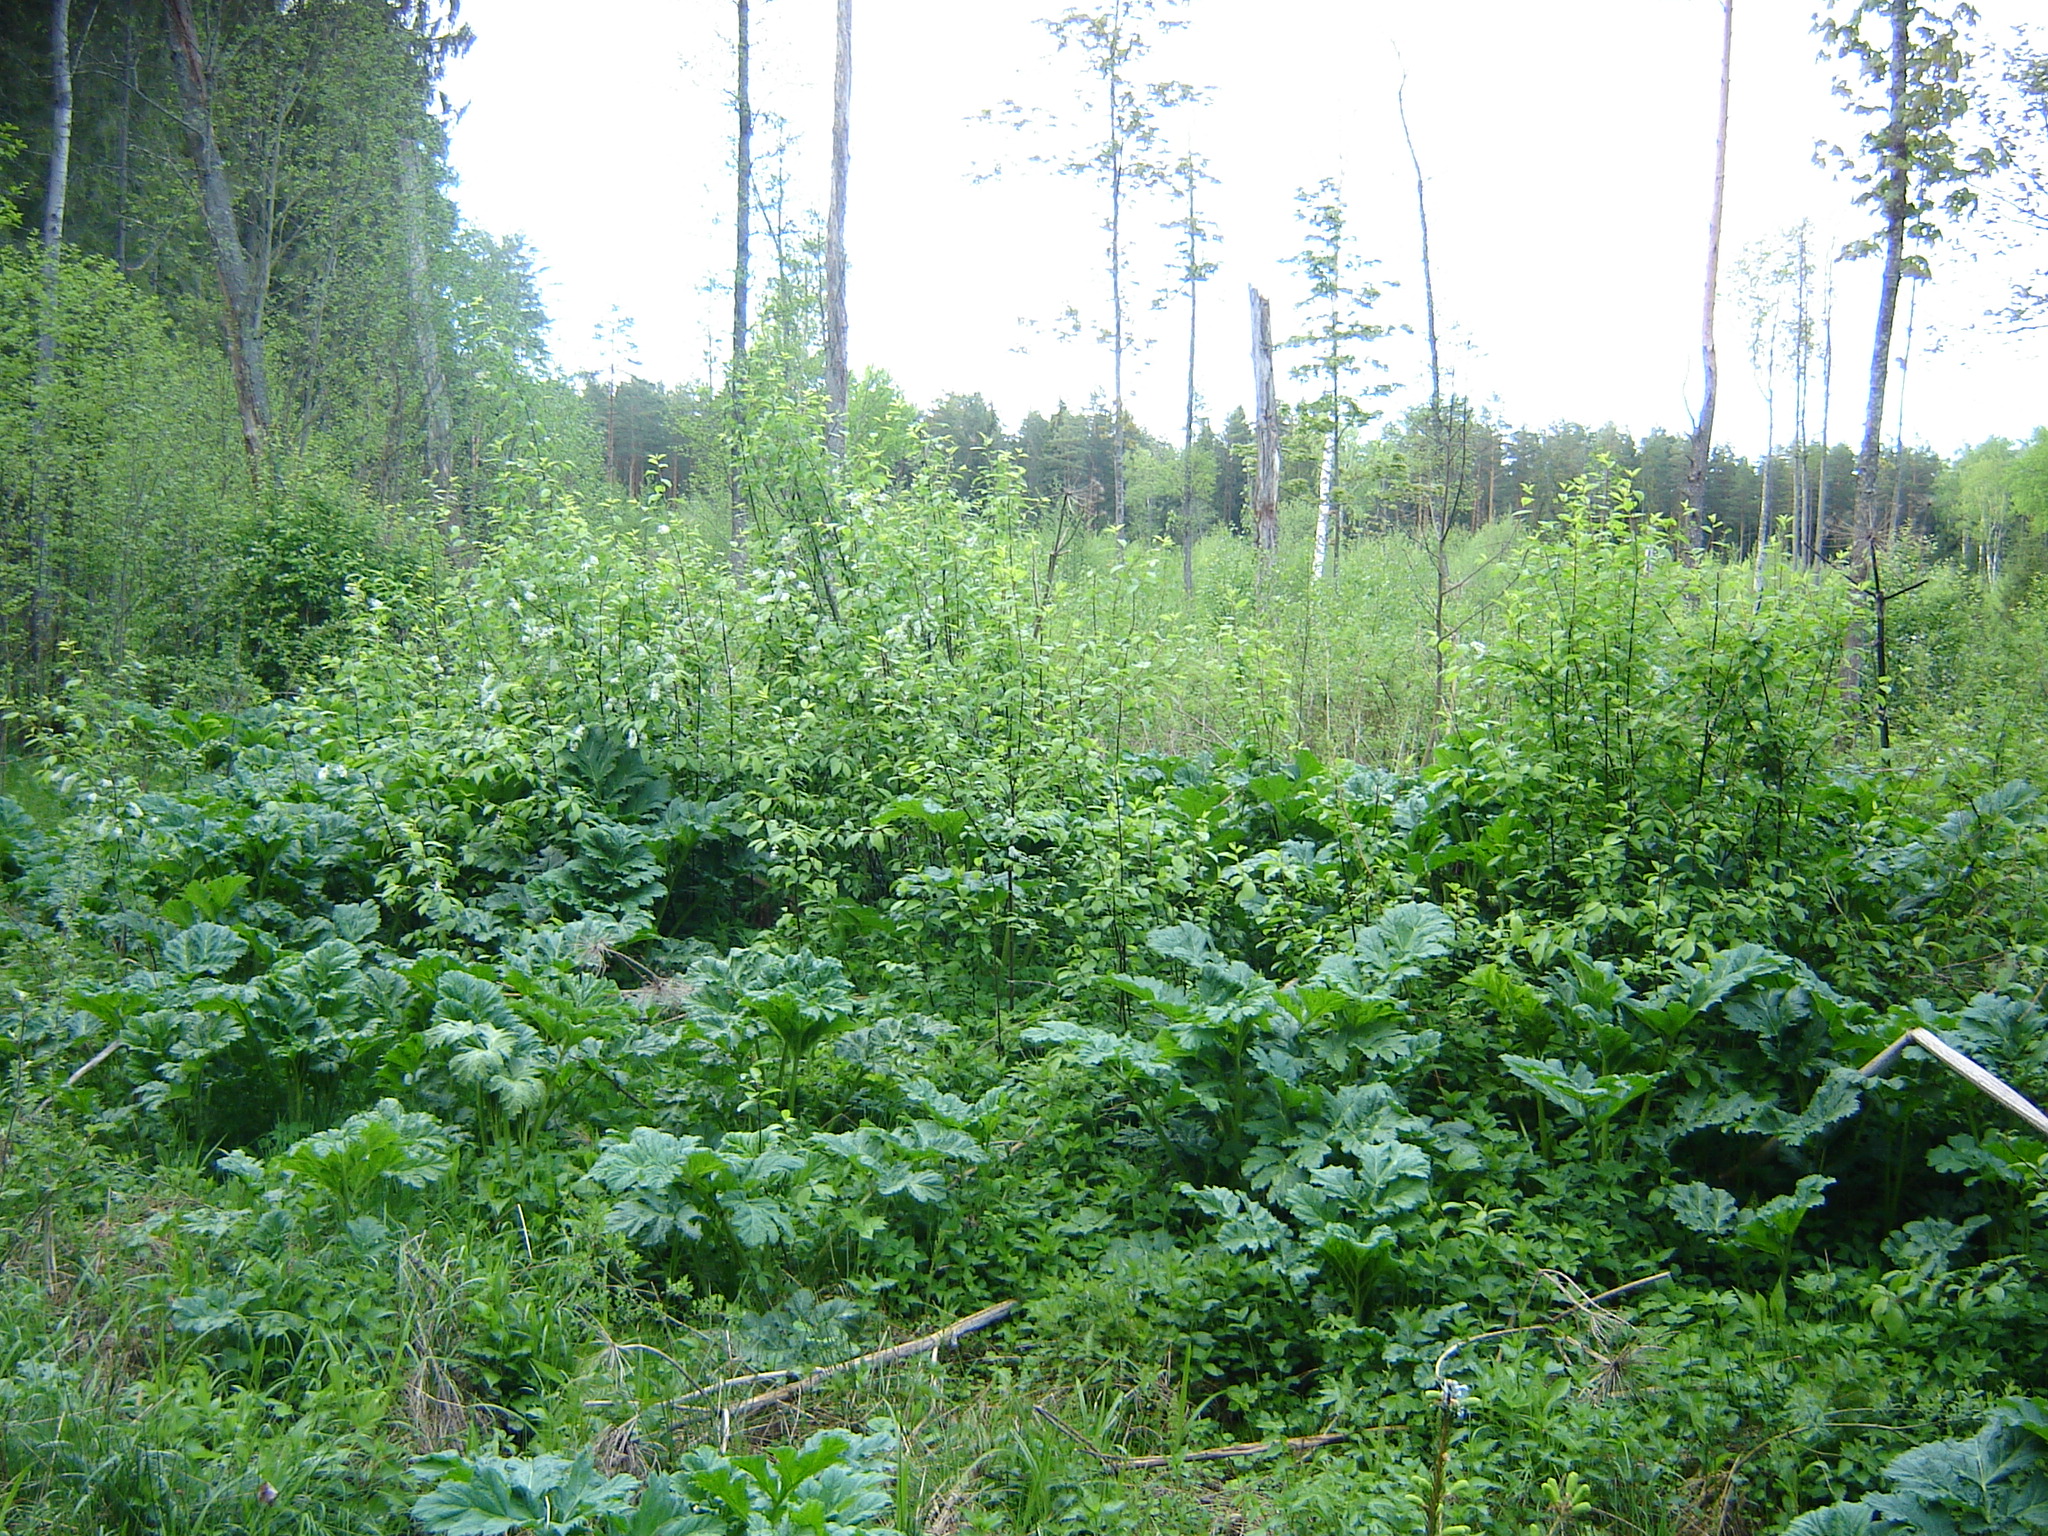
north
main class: Woodland
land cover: Spruce dominated mixed woodland
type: hemiboreal forest and nemoral coniferous forest and mixed broadleaved-coniferous forest
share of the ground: > 75 %
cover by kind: broadleaved forest trees 65 %, coniferous forest trees 25 %, herbaceous plants 10 %
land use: Forestry
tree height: < 5 m
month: May
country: LT
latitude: 56.1084
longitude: 25.2796
